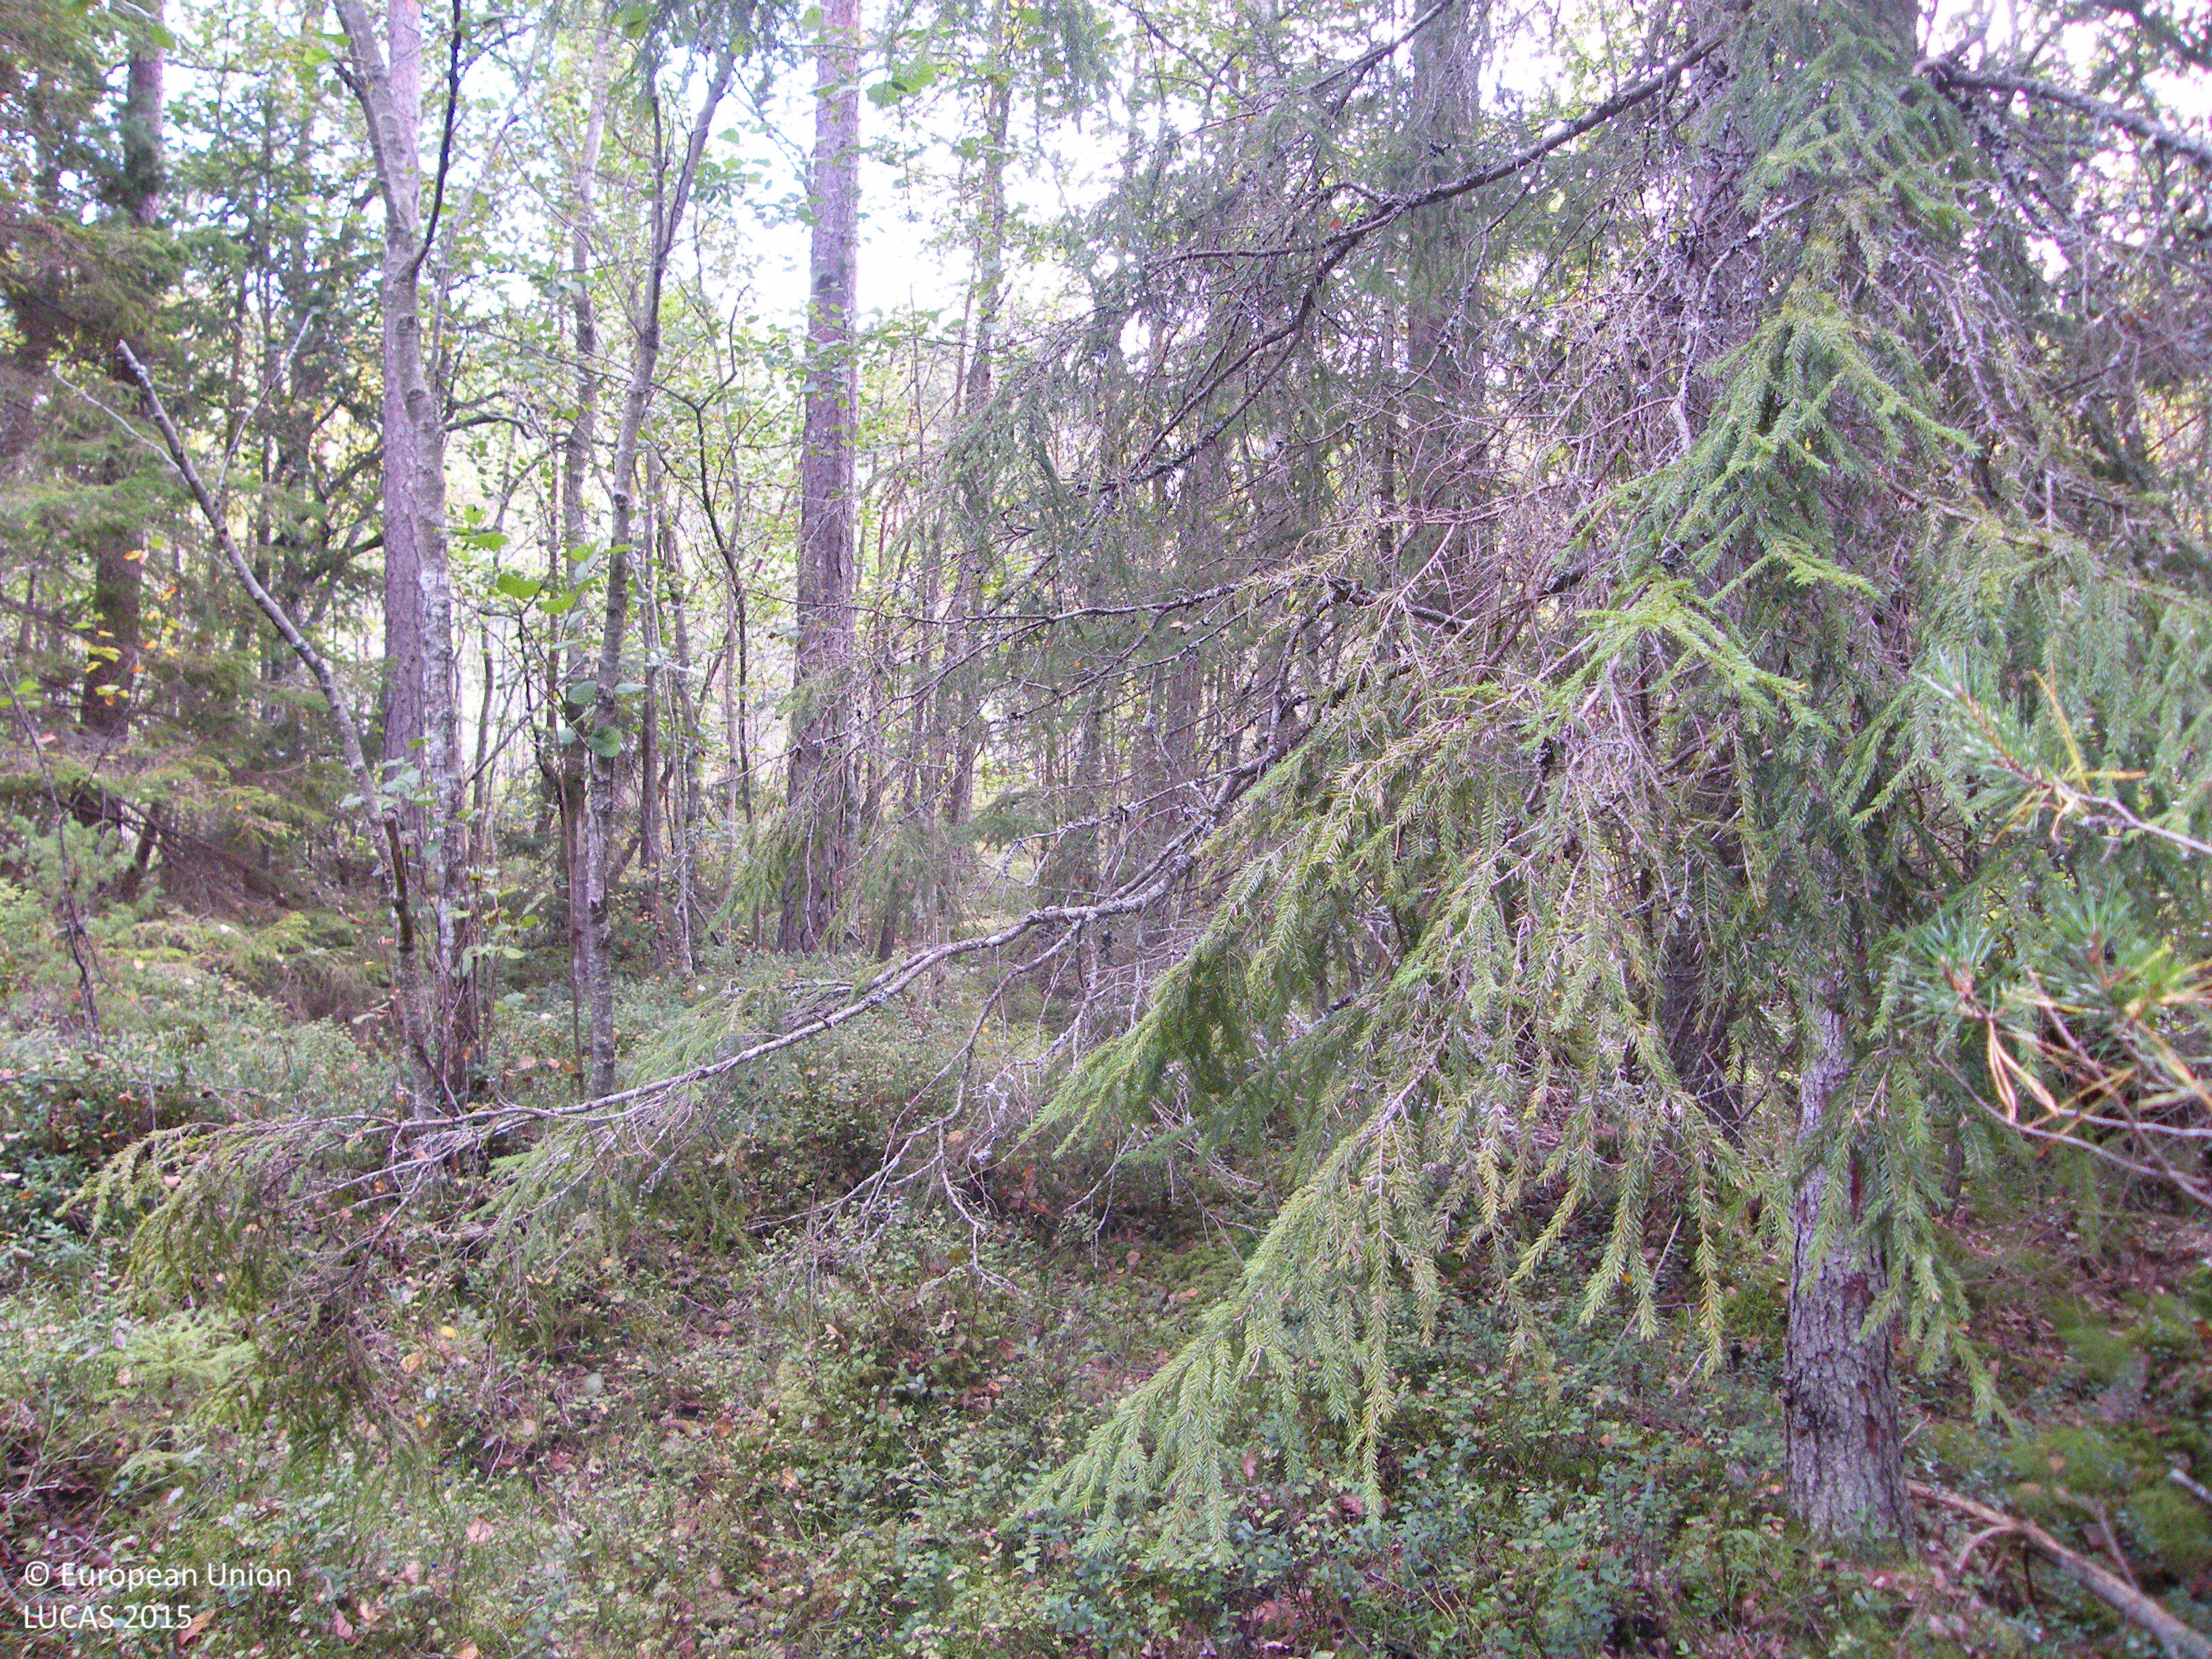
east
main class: Woodland
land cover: Other mixed woodland
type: boreal forest
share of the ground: > 75 %
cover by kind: coniferous forest trees 55 %, broadleaved forest trees 20 %, shrubs 15 %, lichens and mosses 10 %
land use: Forestry
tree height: > 5 m
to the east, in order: Other mixed woodland; Pine dominated coniferous woodland; Tracks; Pine dominated coniferous woodland; Paved roads, cycling and walking lanes; Pine dominated coniferous woodland; Pine dominated mixed woodland; Inland marshes; Pine dominated mixed woodland
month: September
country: SE
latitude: 59.4938
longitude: 15.5544
